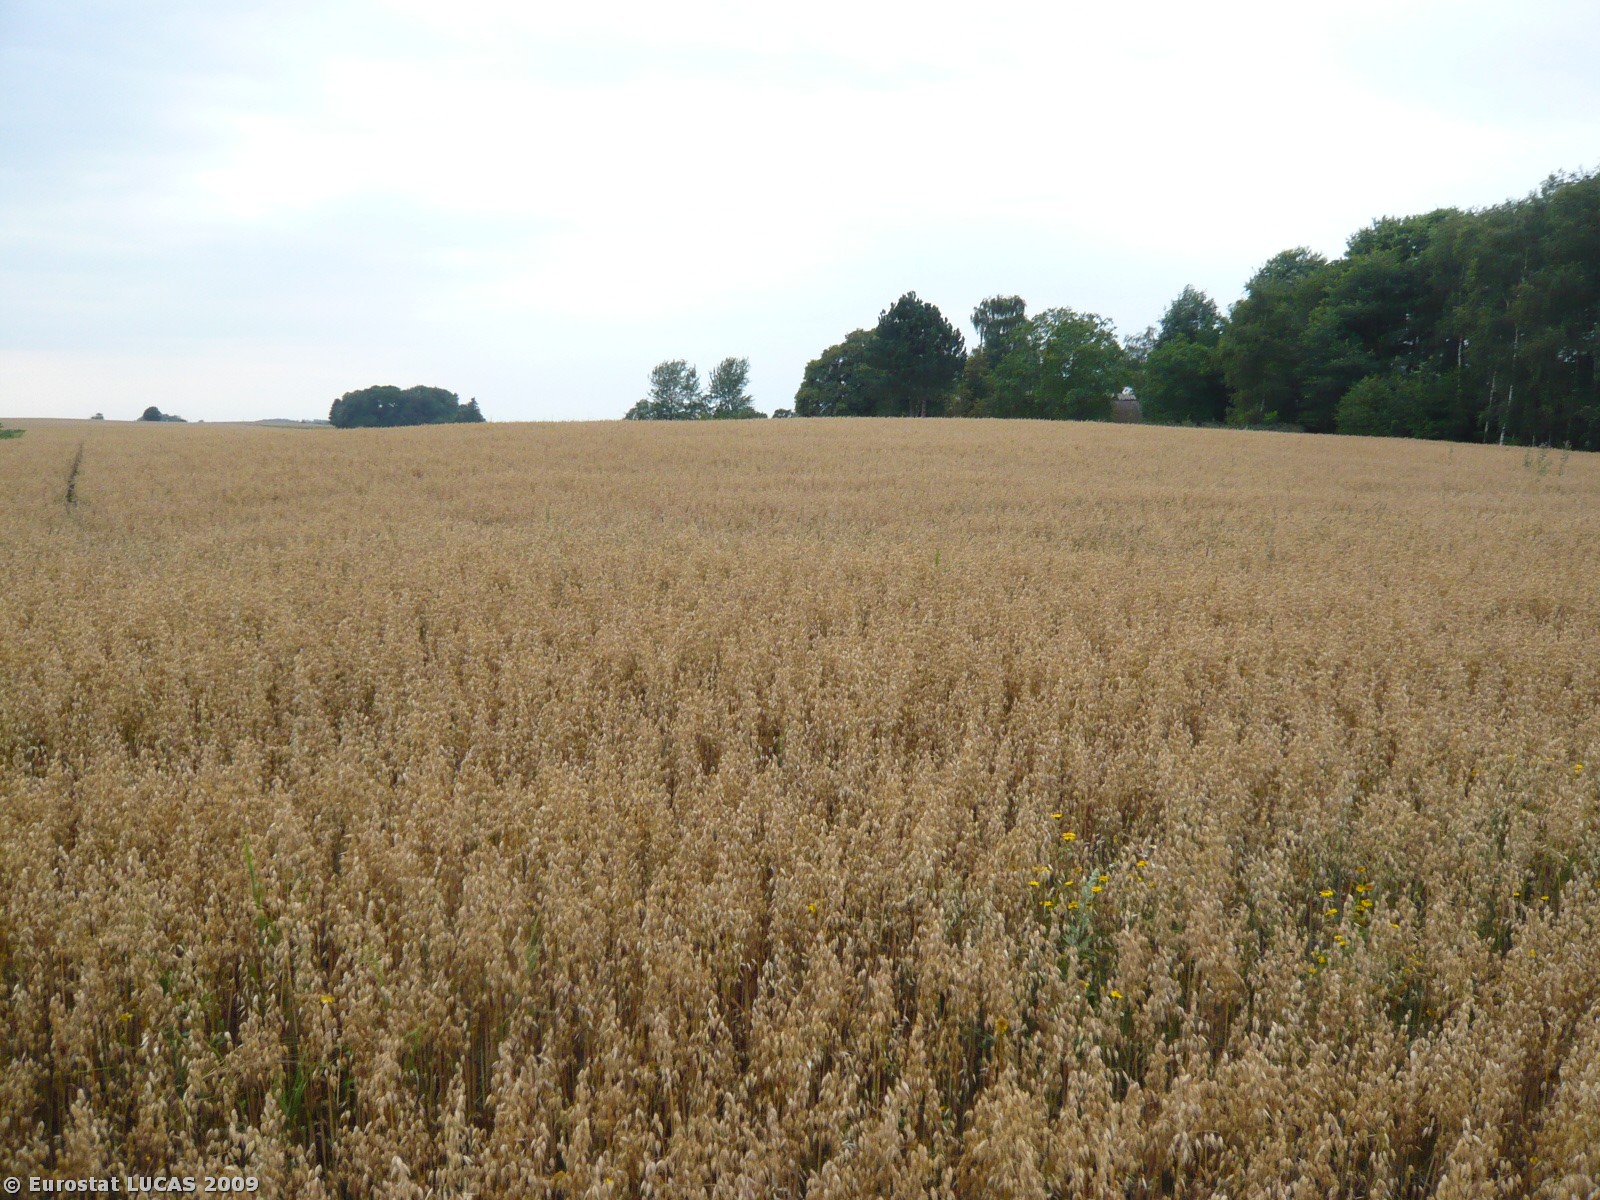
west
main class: Cropland
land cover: Oats
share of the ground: > 75 %
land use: Agriculture (excluding fallow land and kitchen gardens)
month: July
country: DK
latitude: 55.8640
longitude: 12.1551
